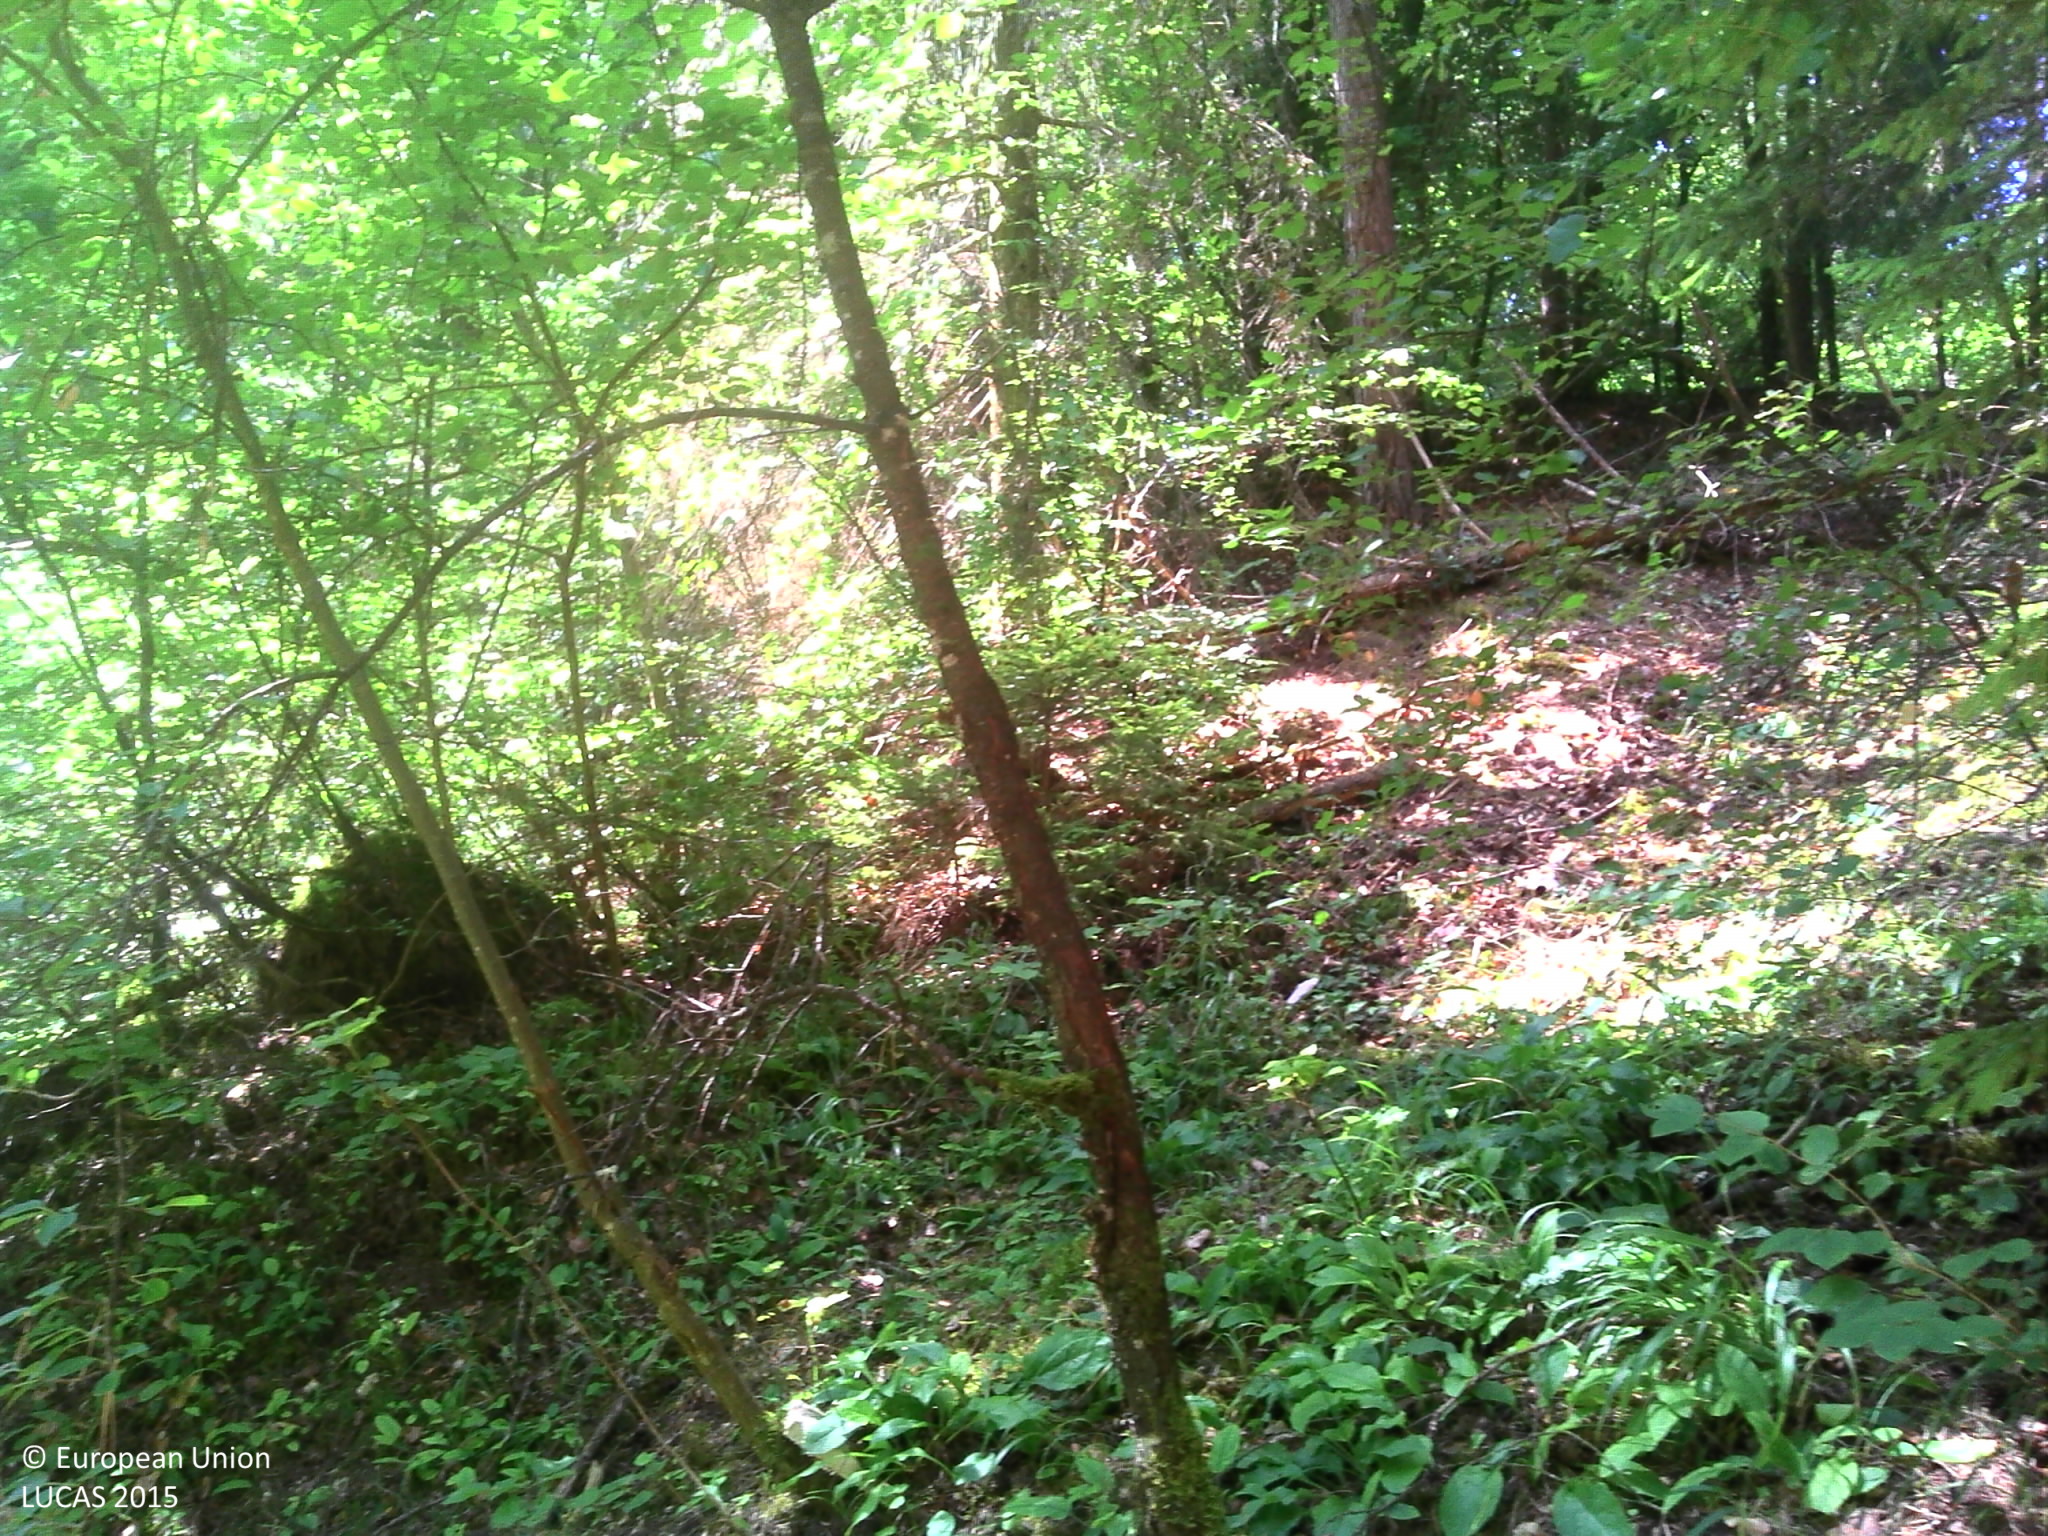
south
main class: Woodland
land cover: Spruce dominated coniferous woodland
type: hemiboreal forest and nemoral coniferous forest and mixed broadleaved-coniferous forest
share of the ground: > 75 %
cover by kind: coniferous forest trees 60 %, broadleaved forest trees 15 %, herbaceous plants 15 %, lichens and mosses 10 %
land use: Forestry
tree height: > 5 m
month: July
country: FR
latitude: 47.9350
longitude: 5.1137
